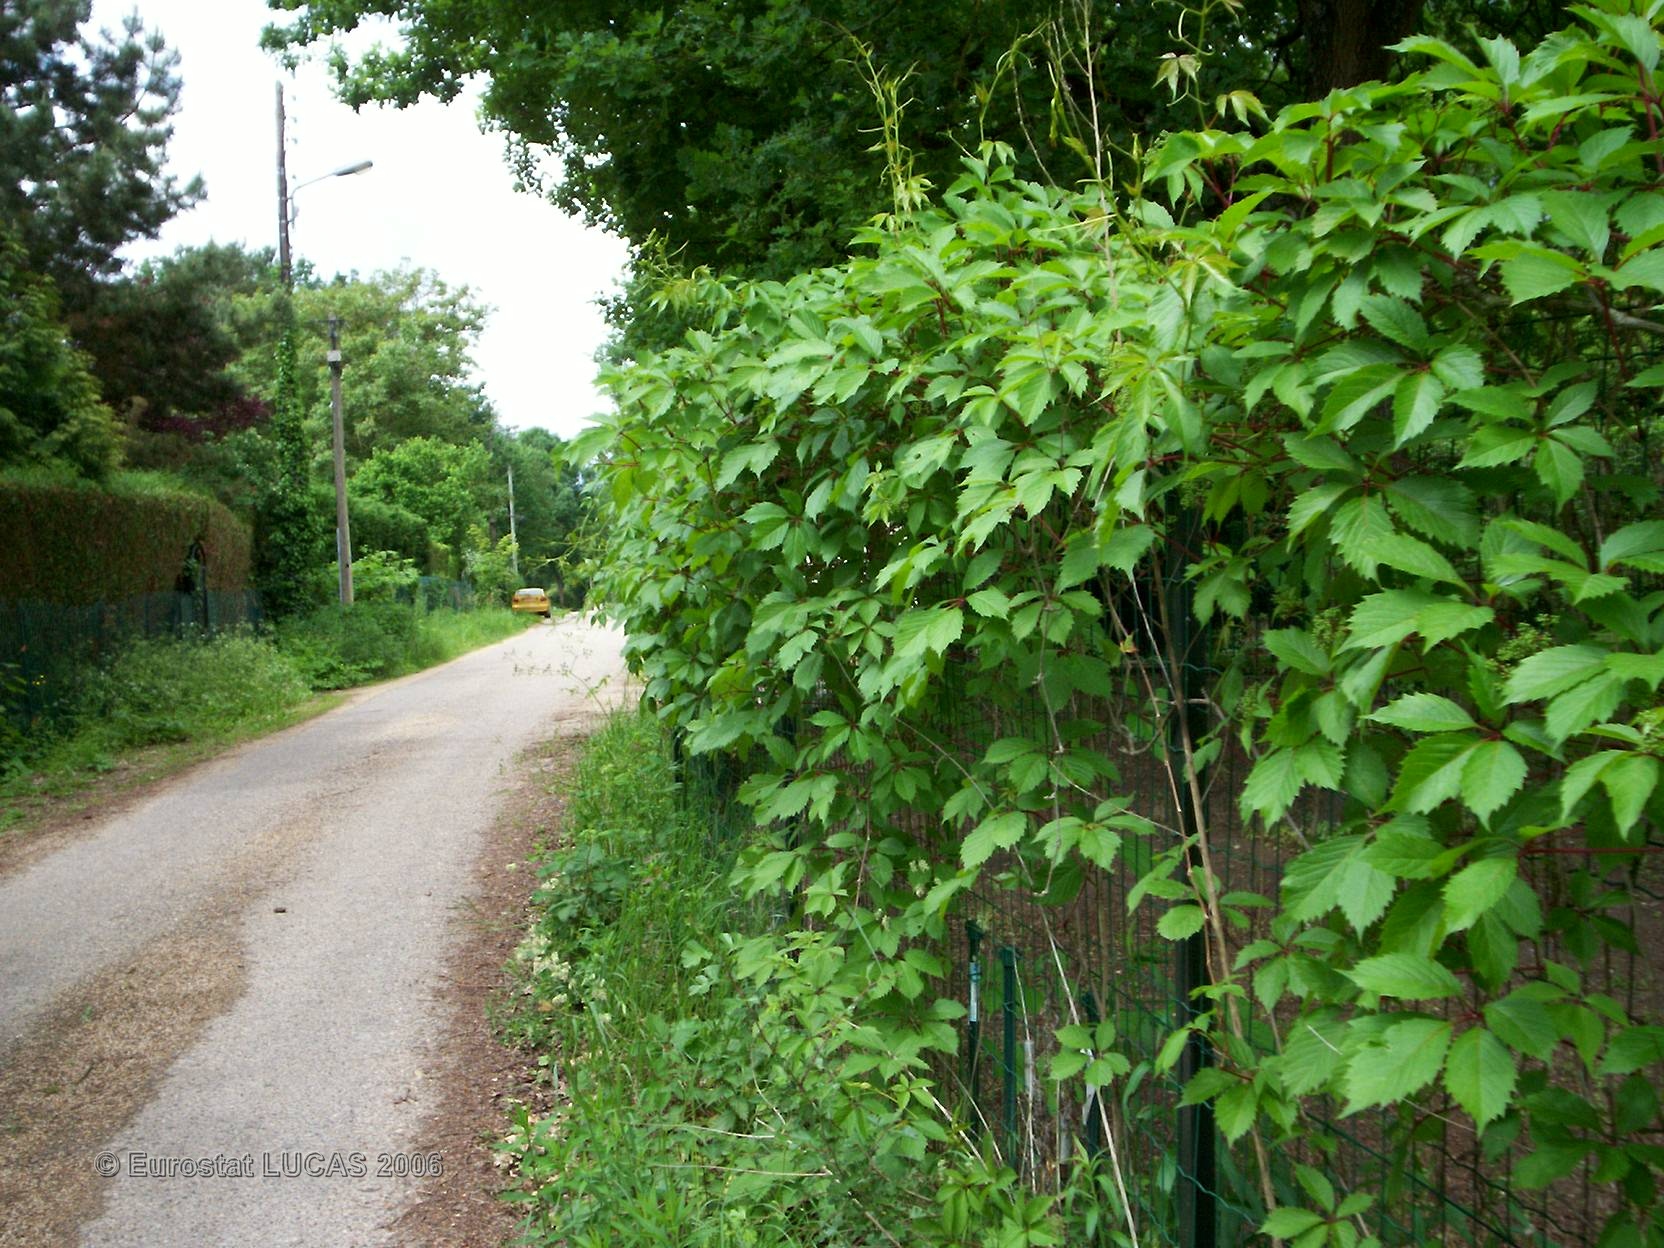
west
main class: Grassland
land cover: Grassland with sparse tree/shrub cover
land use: Residential
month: May
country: FR
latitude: 48.4548
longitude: 2.7567
